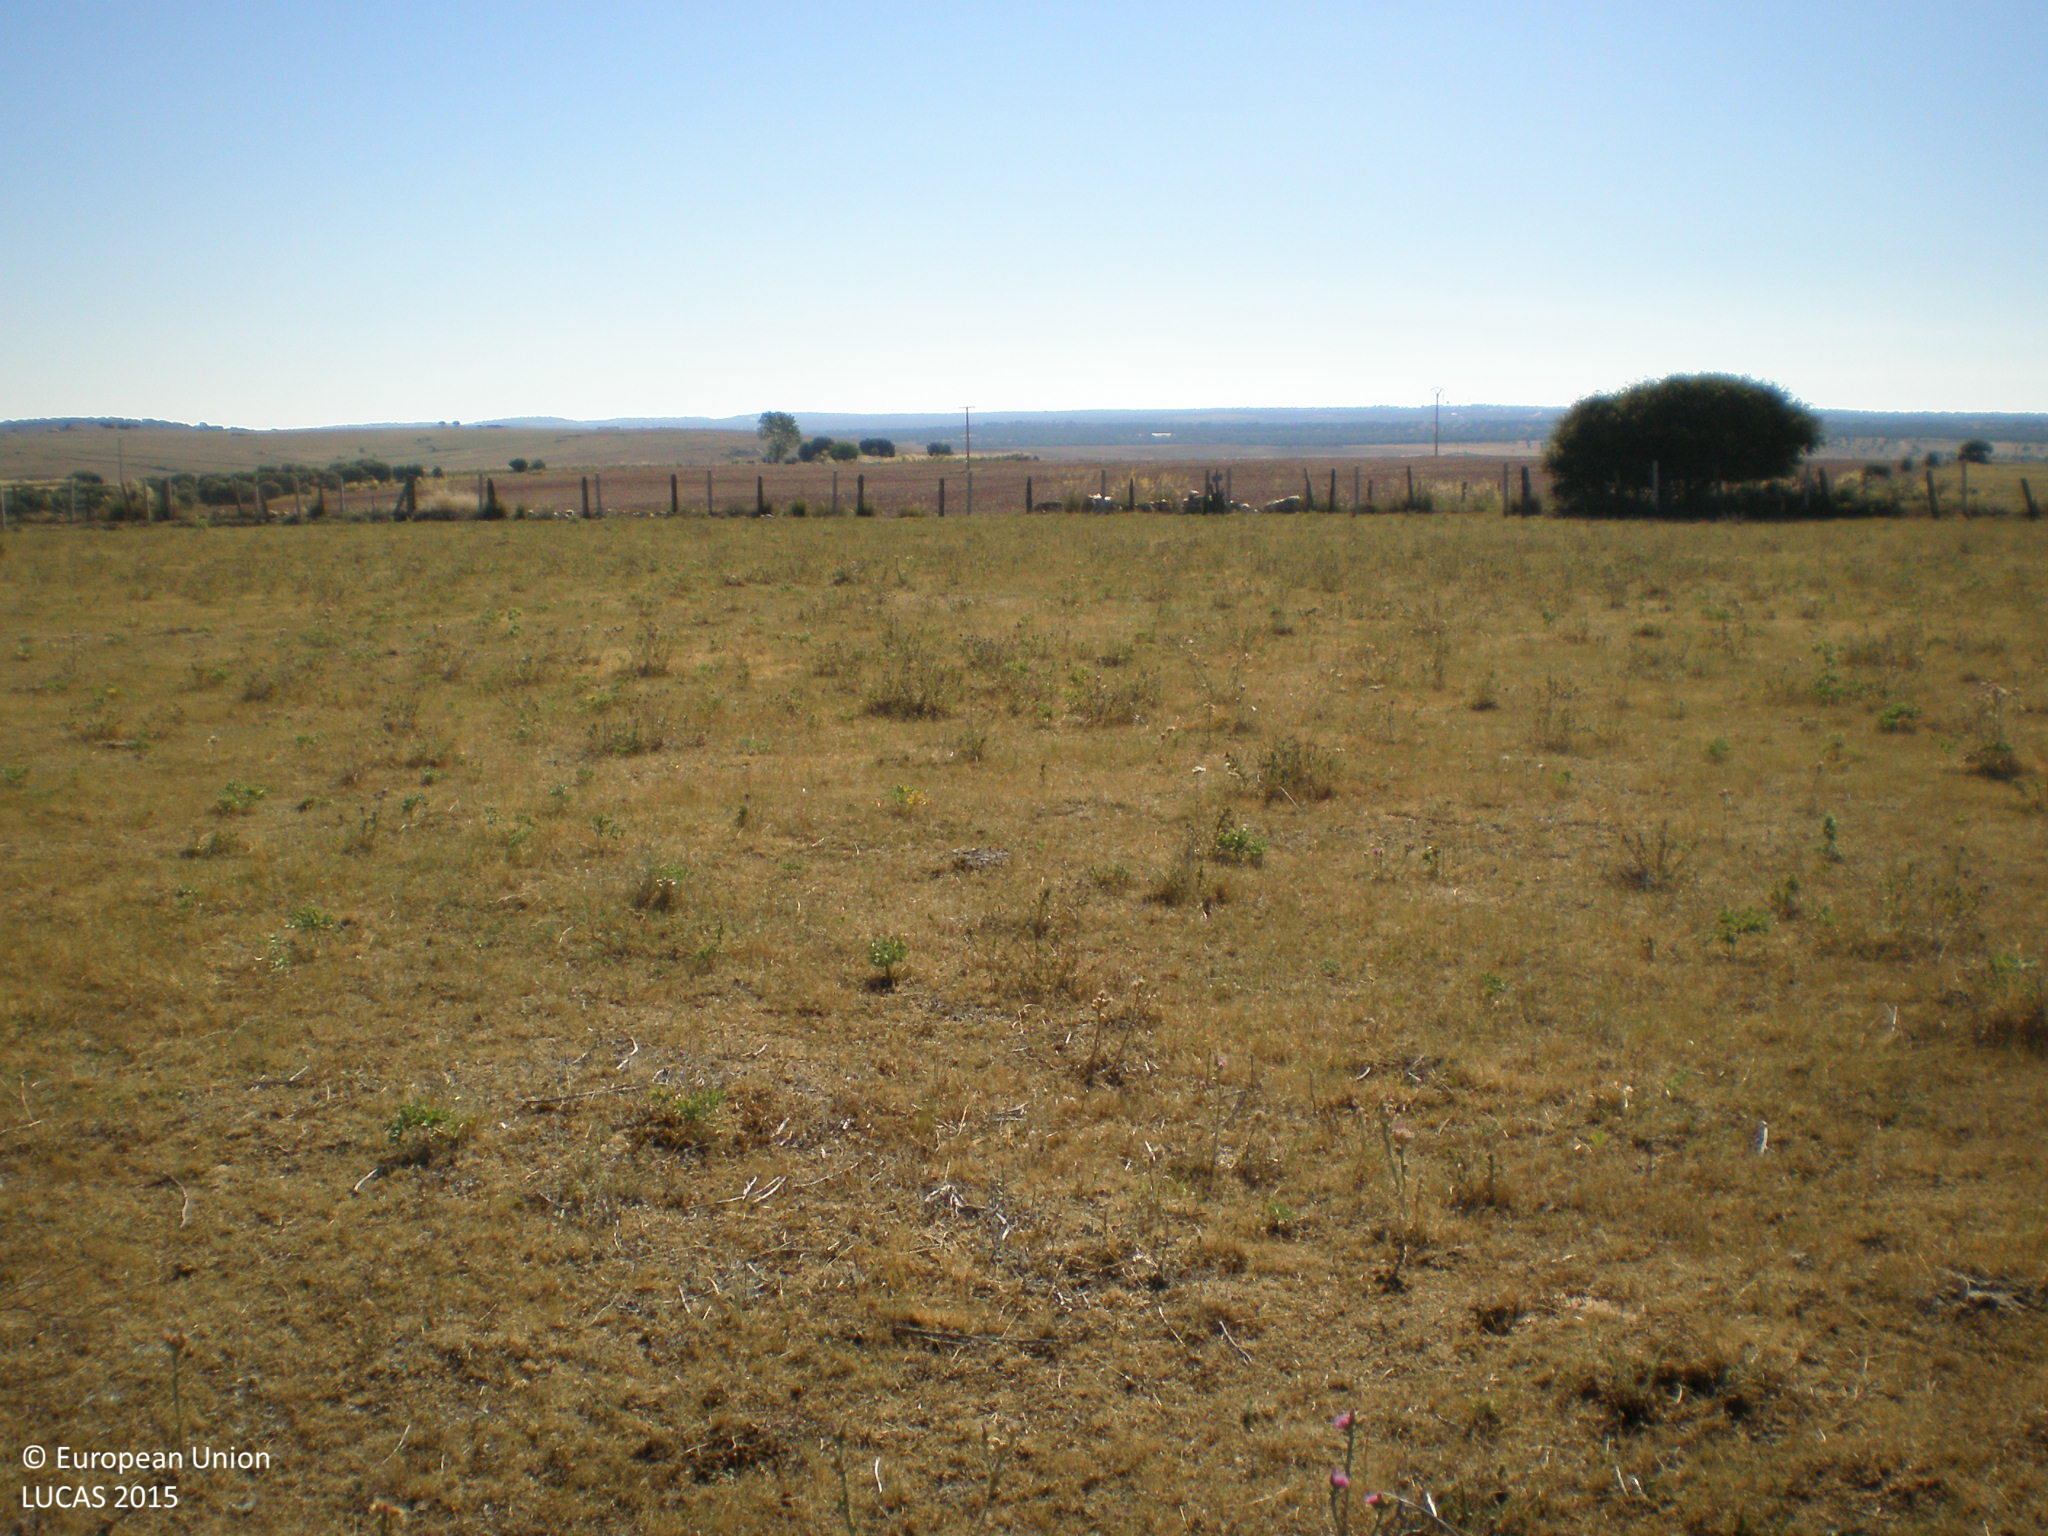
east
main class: Grassland
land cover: Grassland without tree/shrub cover
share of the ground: > 75 %
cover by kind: herbaceous plants 100 %
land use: Agriculture (excluding fallow land and kitchen gardens)
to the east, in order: Grassland without tree/shrub cover; Fences; Other bare soil
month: June
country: ES
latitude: 40.8125
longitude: -5.7127
